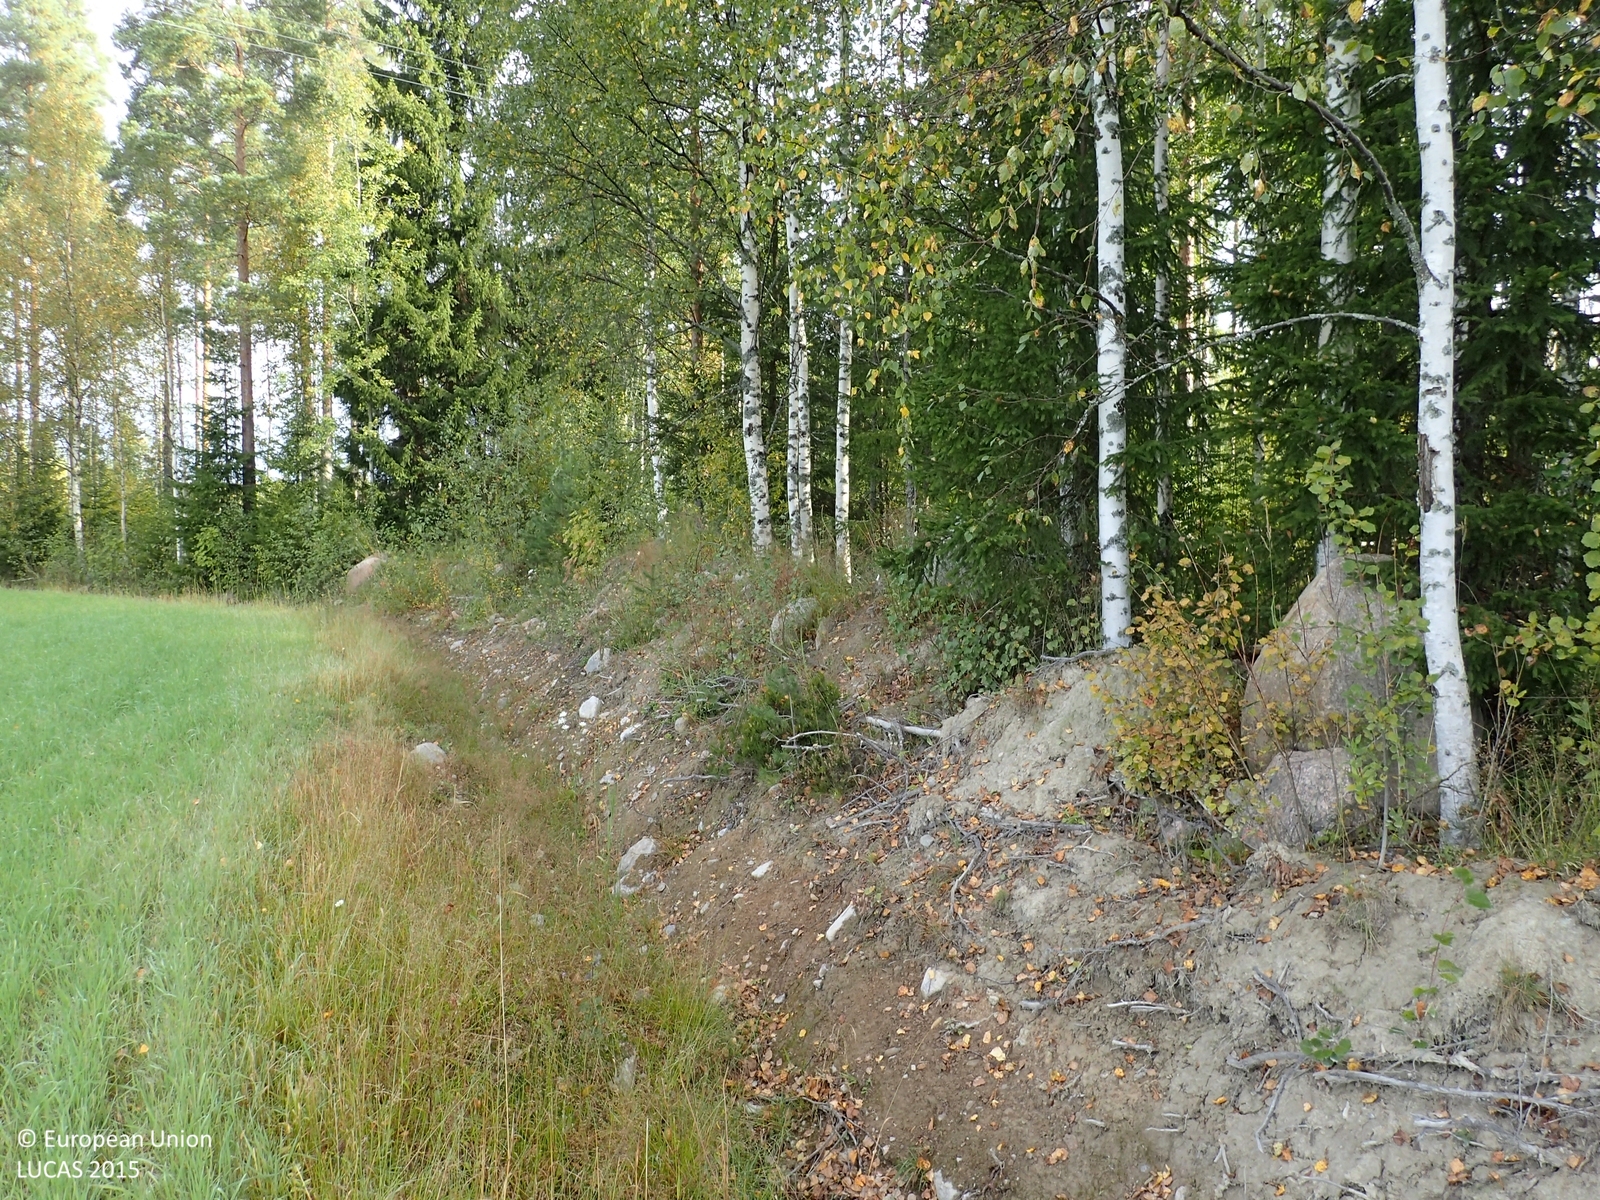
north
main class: Cropland
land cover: Temporary grasslands
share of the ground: > 75 %
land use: Agriculture (excluding fallow land and kitchen gardens)
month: September
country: FI
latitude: 63.1203
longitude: 25.9570
